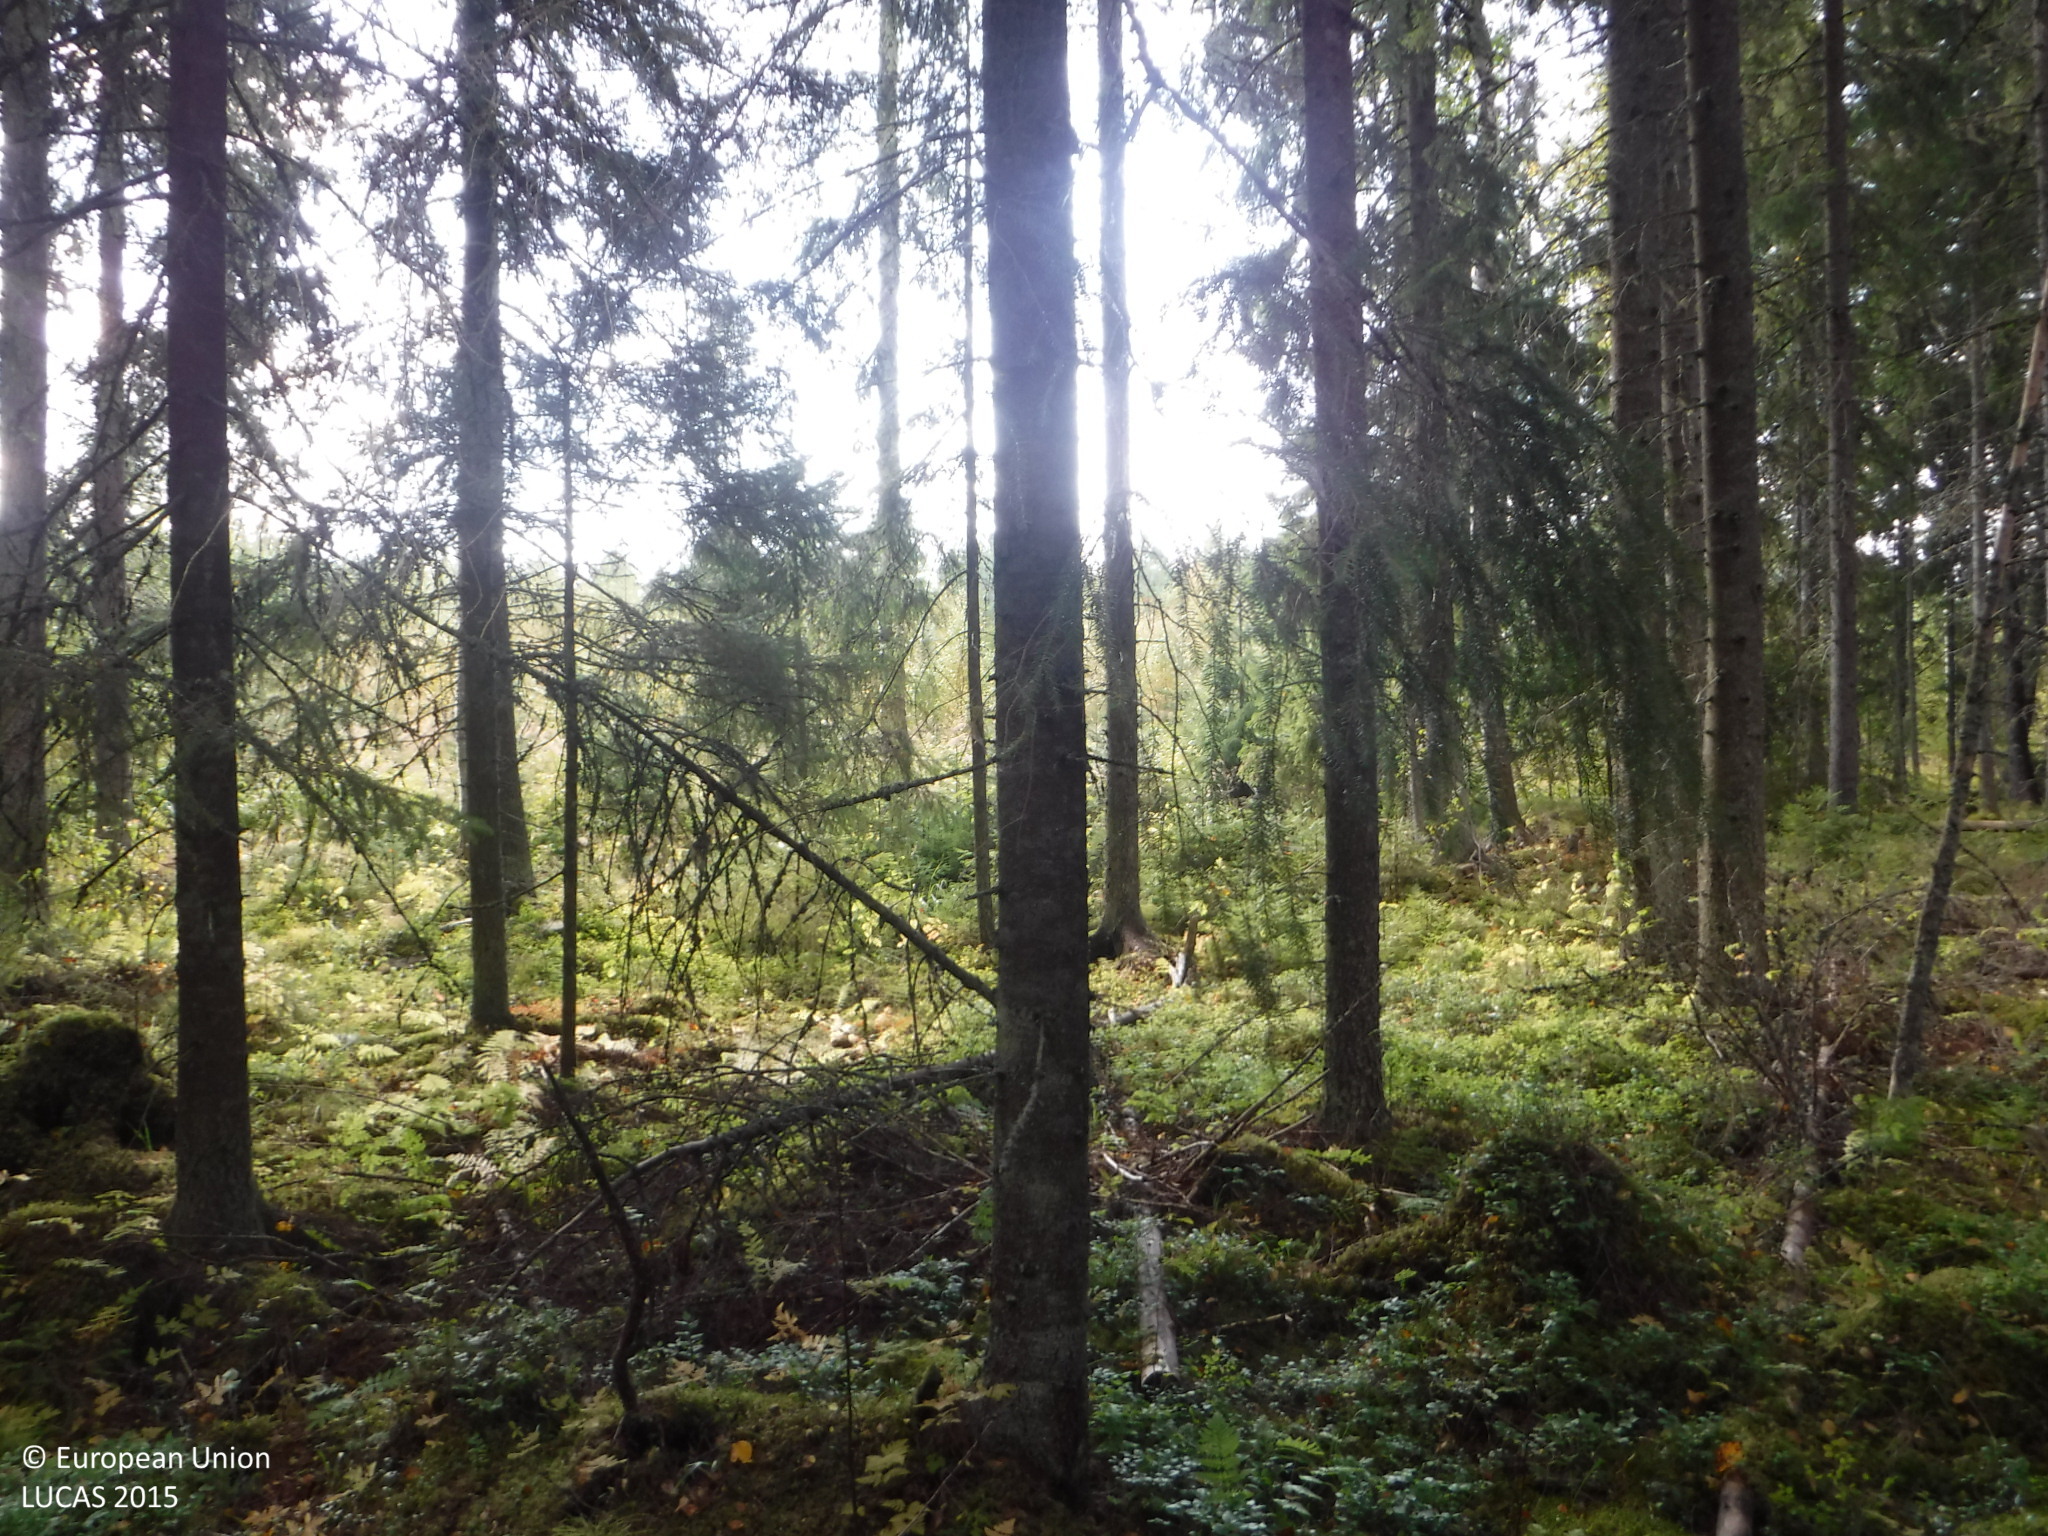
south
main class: Woodland
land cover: Spruce dominated coniferous woodland
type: boreal forest
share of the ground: 50 - 75 %
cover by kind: coniferous forest trees 60 %, herbaceous plants 20 %, broadleaved forest trees 10 %, lichens and mosses 10 %
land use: Forestry
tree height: > 5 m
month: September
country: FI
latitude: 61.7020
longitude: 22.1017
